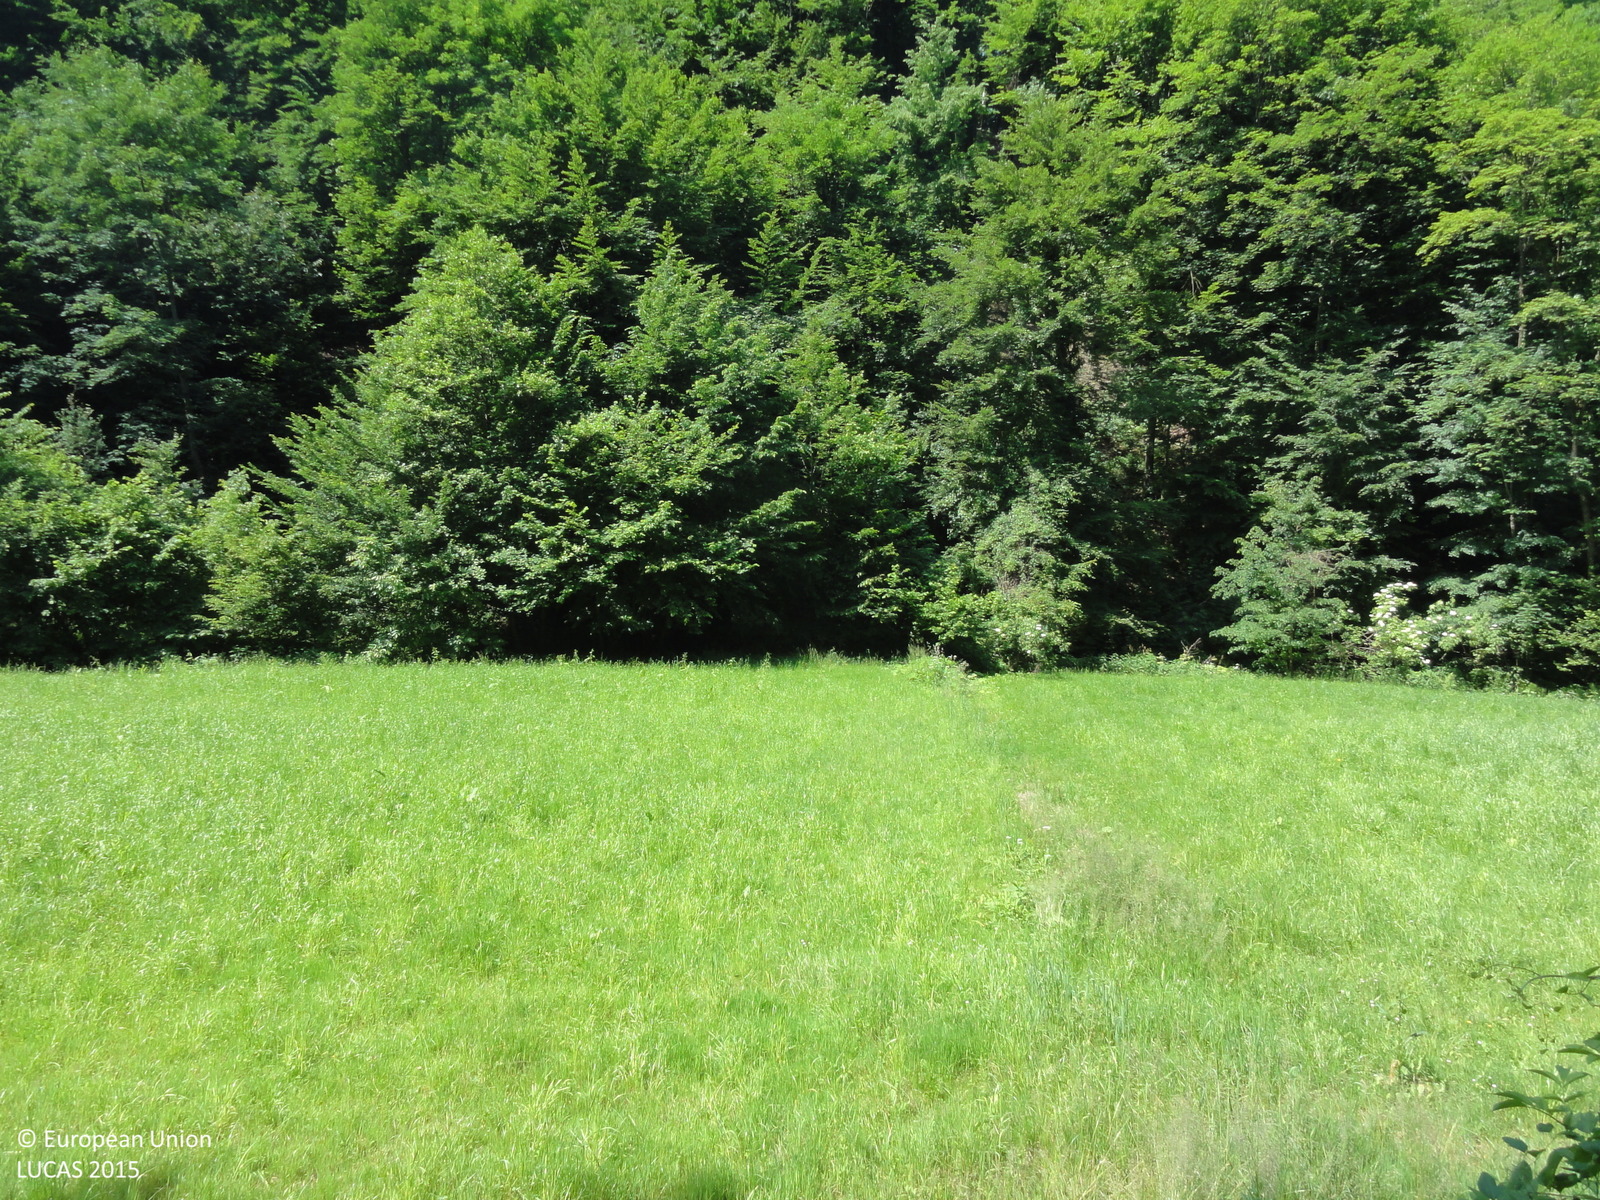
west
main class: Grassland
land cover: Spontaneously vegetated surfaces
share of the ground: > 75 %
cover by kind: herbaceous plants 95 %, shrubs 5 %
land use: Semi-natural and natural areas not in use
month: June
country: SI
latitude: 46.3394
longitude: 15.7803
